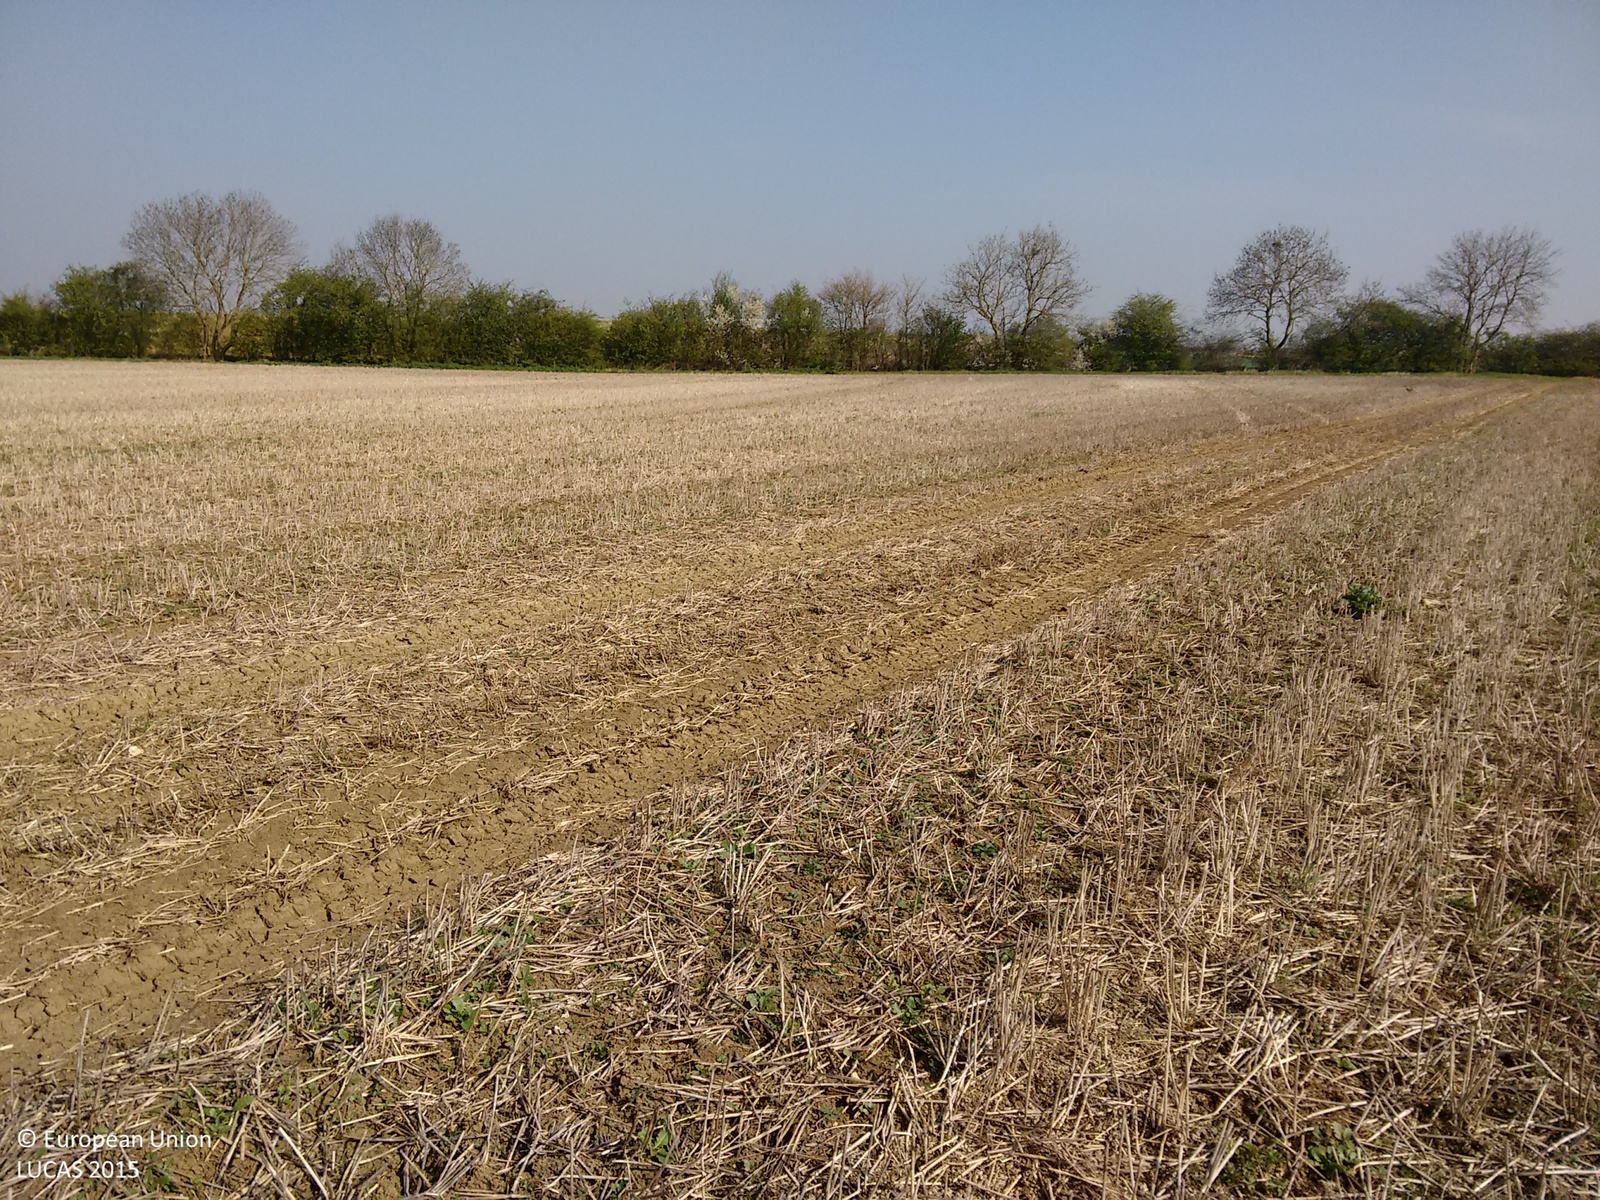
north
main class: Cropland
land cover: Common wheat
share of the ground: 25 - 50 %
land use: Agriculture (excluding fallow land and kitchen gardens)
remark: Harvested field
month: April
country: GB
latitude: 53.1113
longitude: -0.6612
